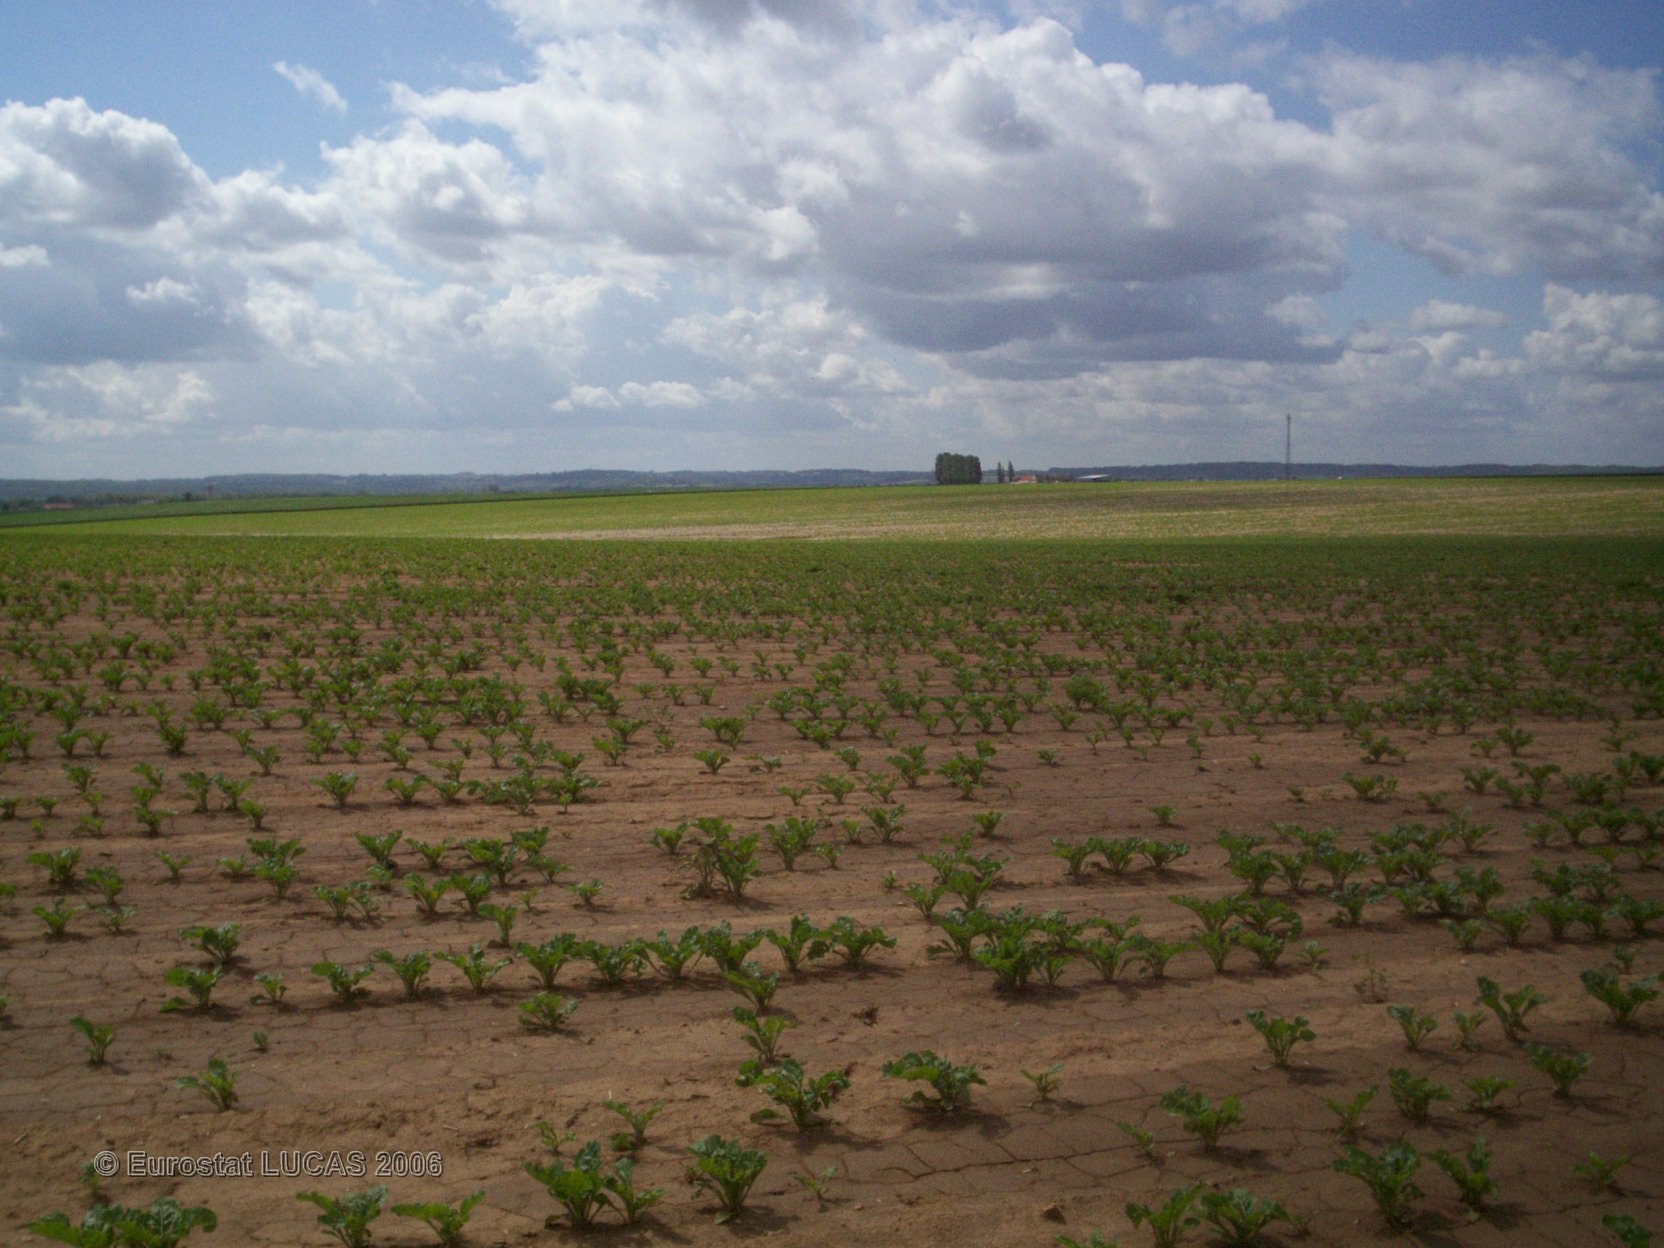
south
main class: Cropland
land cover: Sugar beet
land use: Agriculture (excluding fallow land and kitchen gardens)
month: May
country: FR
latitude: 48.9611
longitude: 2.7648
